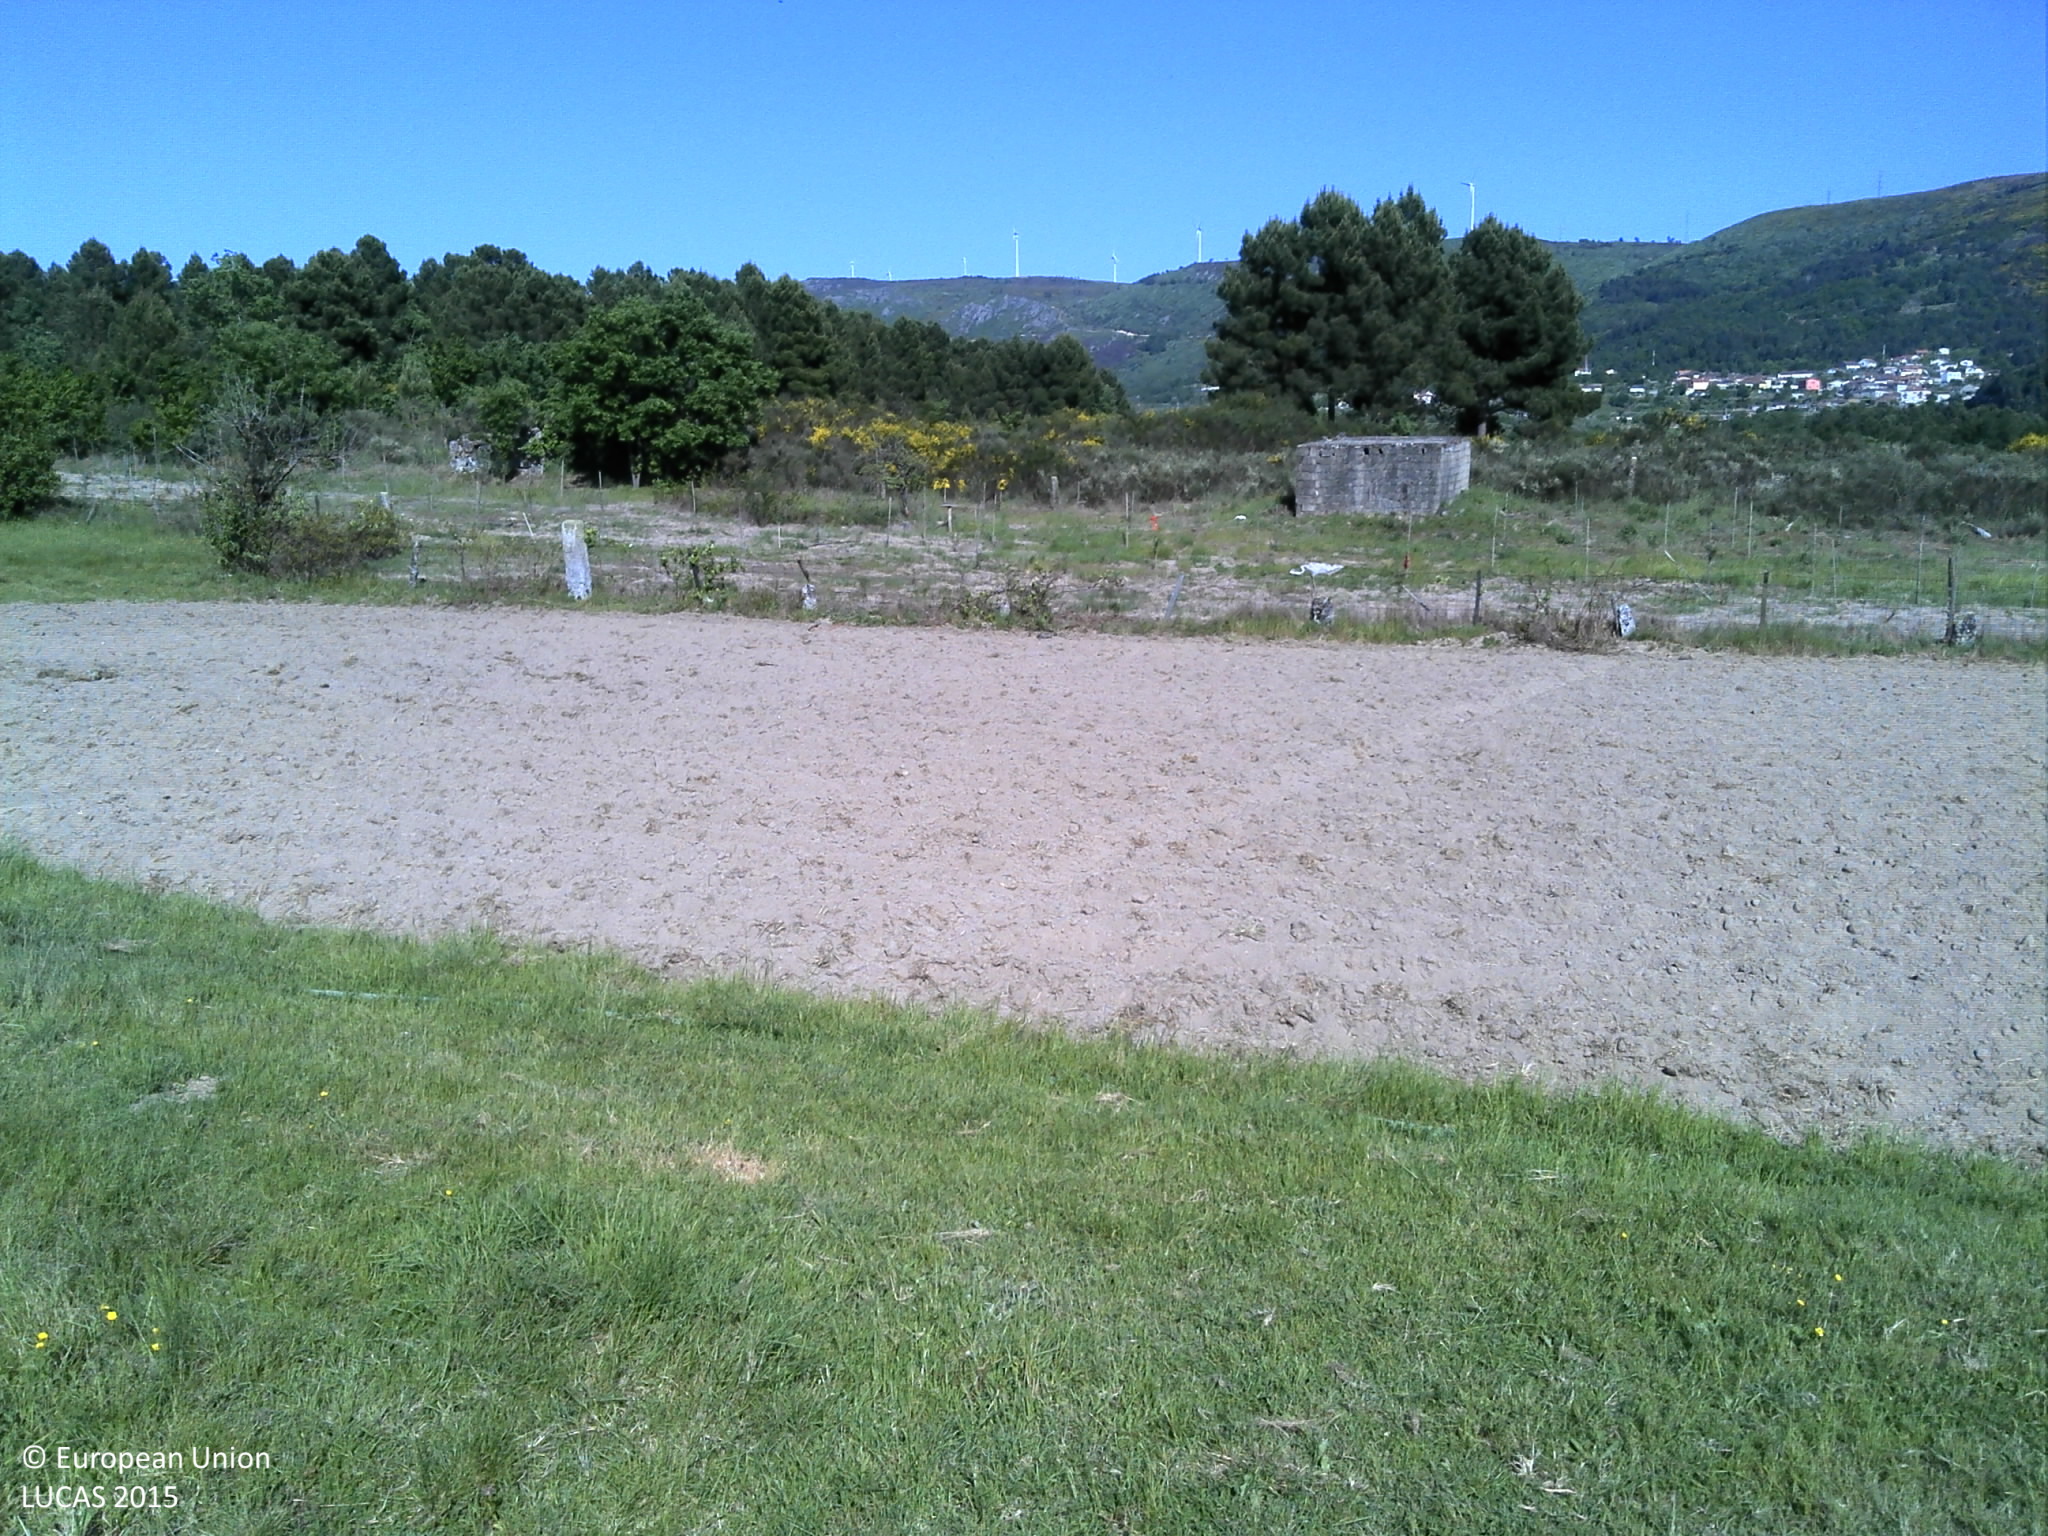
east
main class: Grassland
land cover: Grassland without tree/shrub cover
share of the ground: > 75 %
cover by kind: herbaceous plants 80 %, unconsolidated bare surface 15 %, shrubs 5 %
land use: Agriculture (excluding fallow land and kitchen gardens)
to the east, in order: Grassland without tree/shrub cover; Other bare soil; Fences; Spontaneously vegetated surfaces; Grassland with sparse tree/shrub cover; Artificial constructions; Grassland with sparse tree/shrub cover; Fences; Shrubland without tree cover; Fences; Pine dominated coniferous woodland; Fences; Dry stone walls; Shrubland with sparse tree cover; Pine dominated coniferous woodland
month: May
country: PT
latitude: 41.5636
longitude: -7.5775
